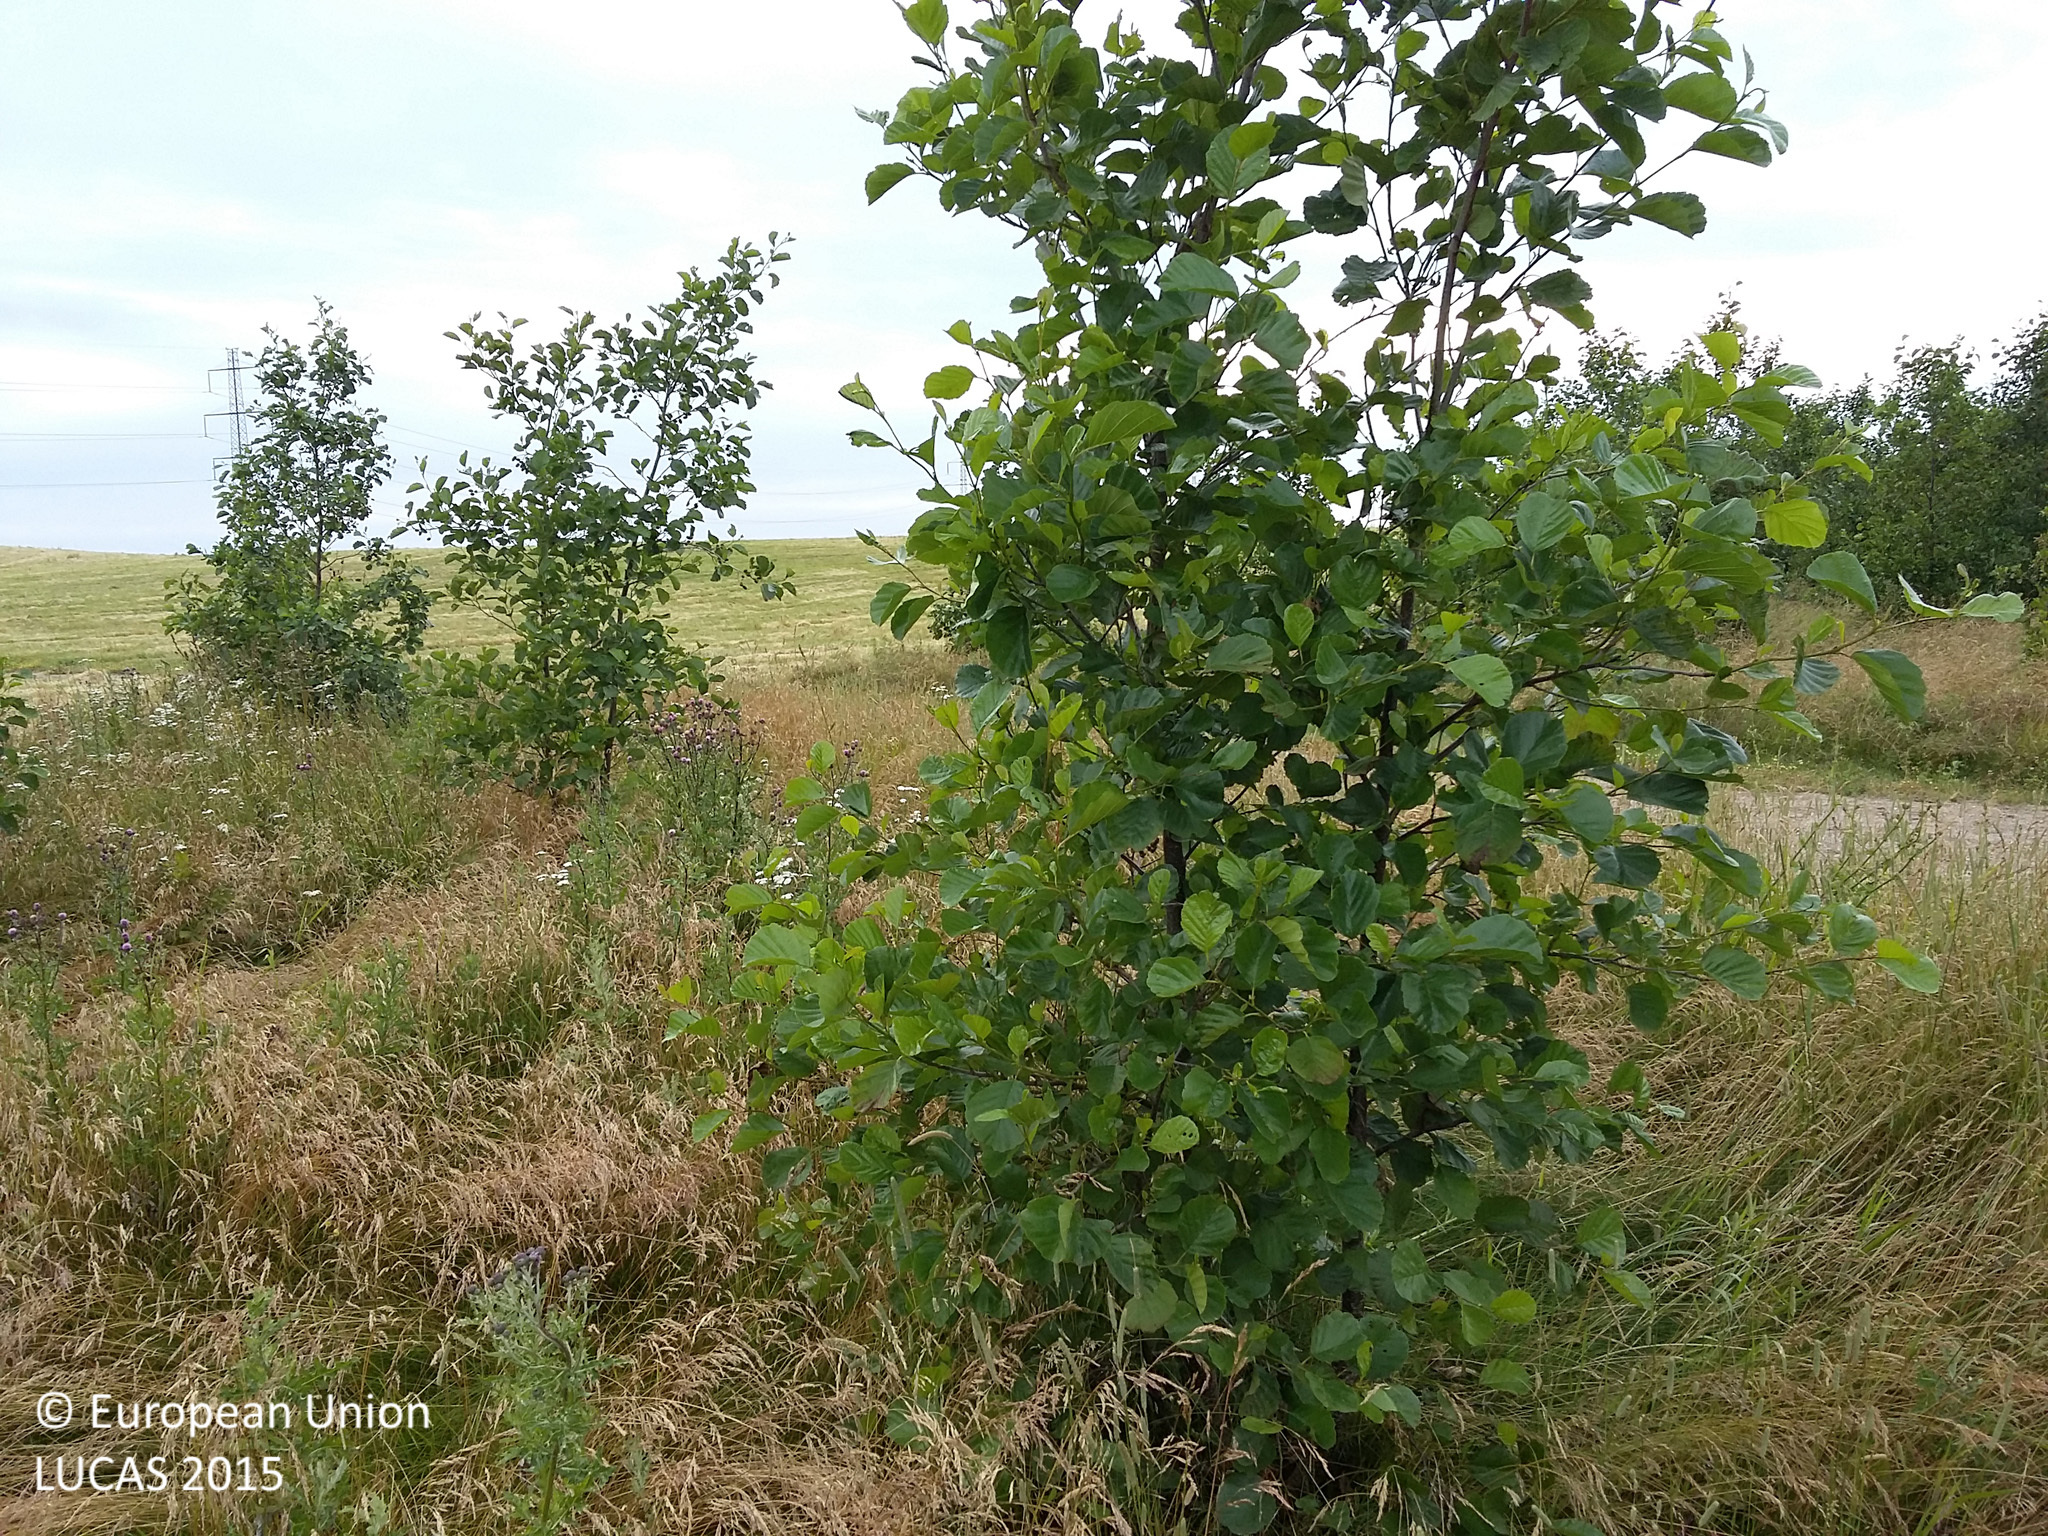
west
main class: Woodland
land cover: Broadleaved woodland
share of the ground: 25 - 50 %
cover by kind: herbaceous plants 65 %, broadleaved forest trees 35 %
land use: Agriculture (excluding fallow land and kitchen gardens)
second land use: Amenities, museums, leisure
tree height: < 5 m
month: July
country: DK
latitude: 55.5338
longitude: 11.3139
